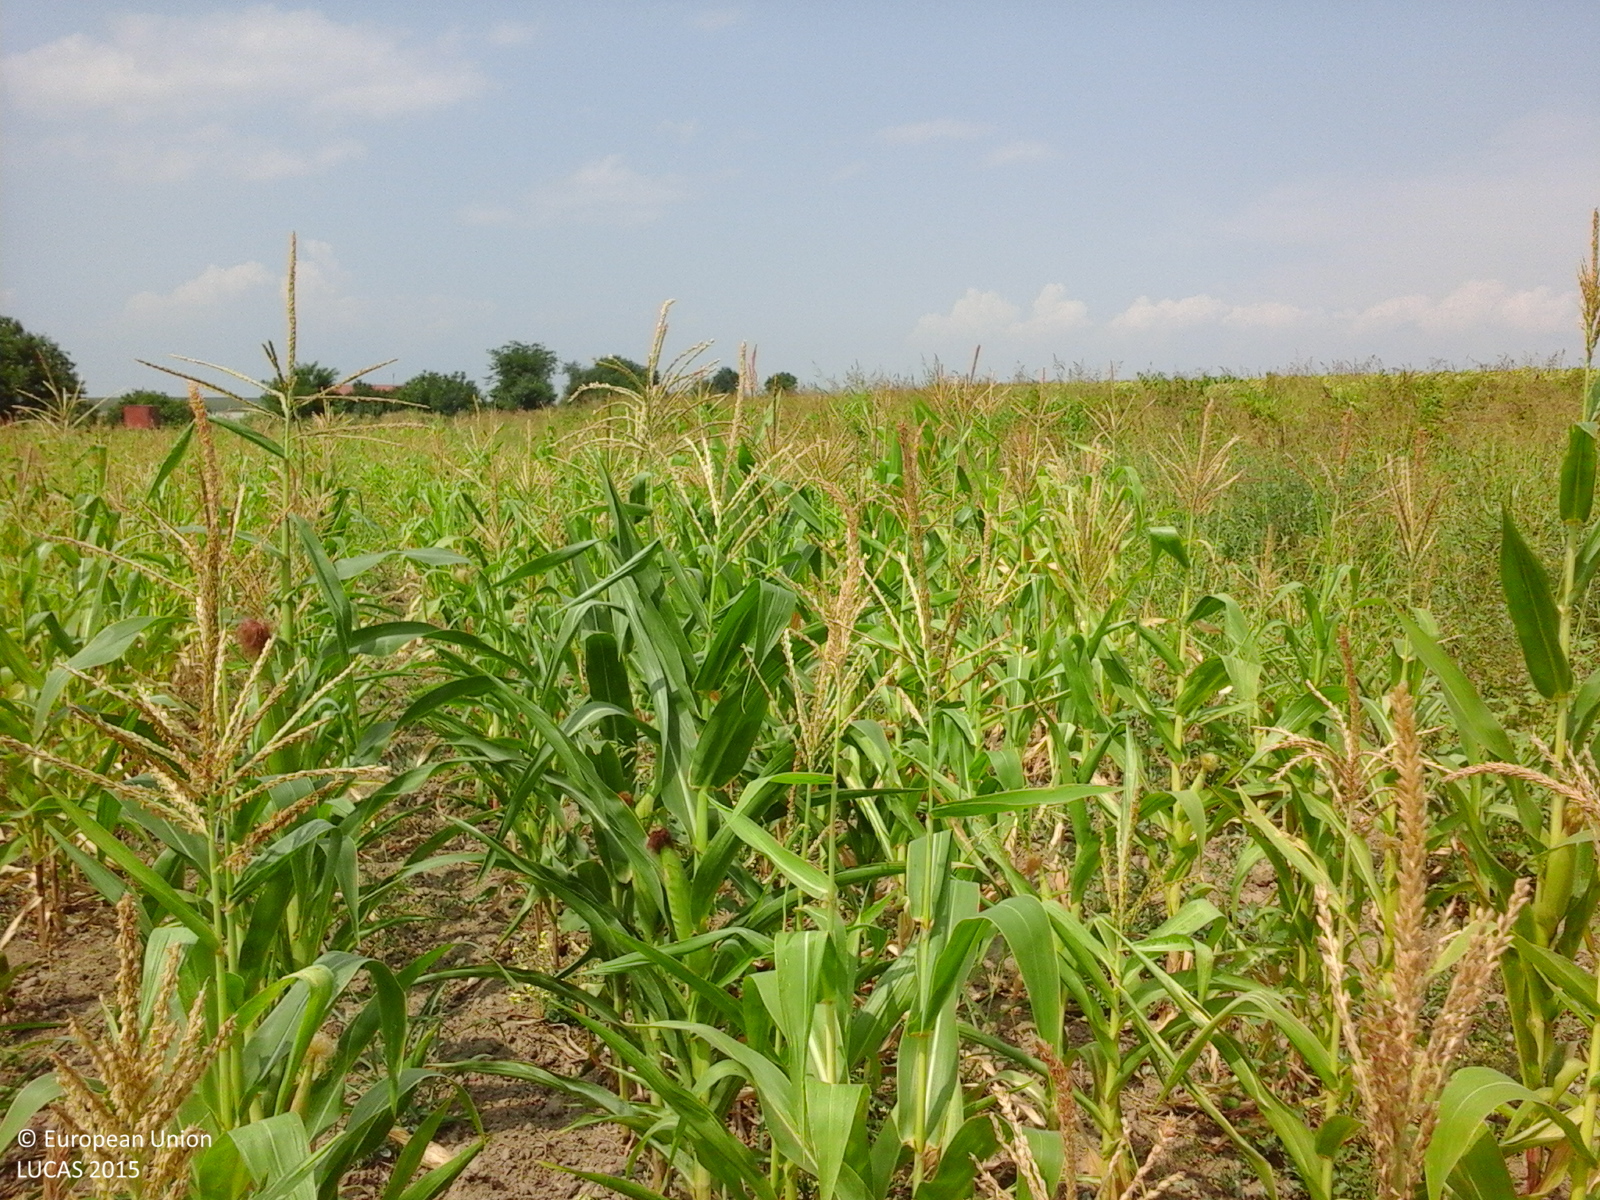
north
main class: Cropland
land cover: Maize
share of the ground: > 75 %
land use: Agriculture (excluding fallow land and kitchen gardens)
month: July
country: RO
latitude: 45.1021
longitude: 28.7301
